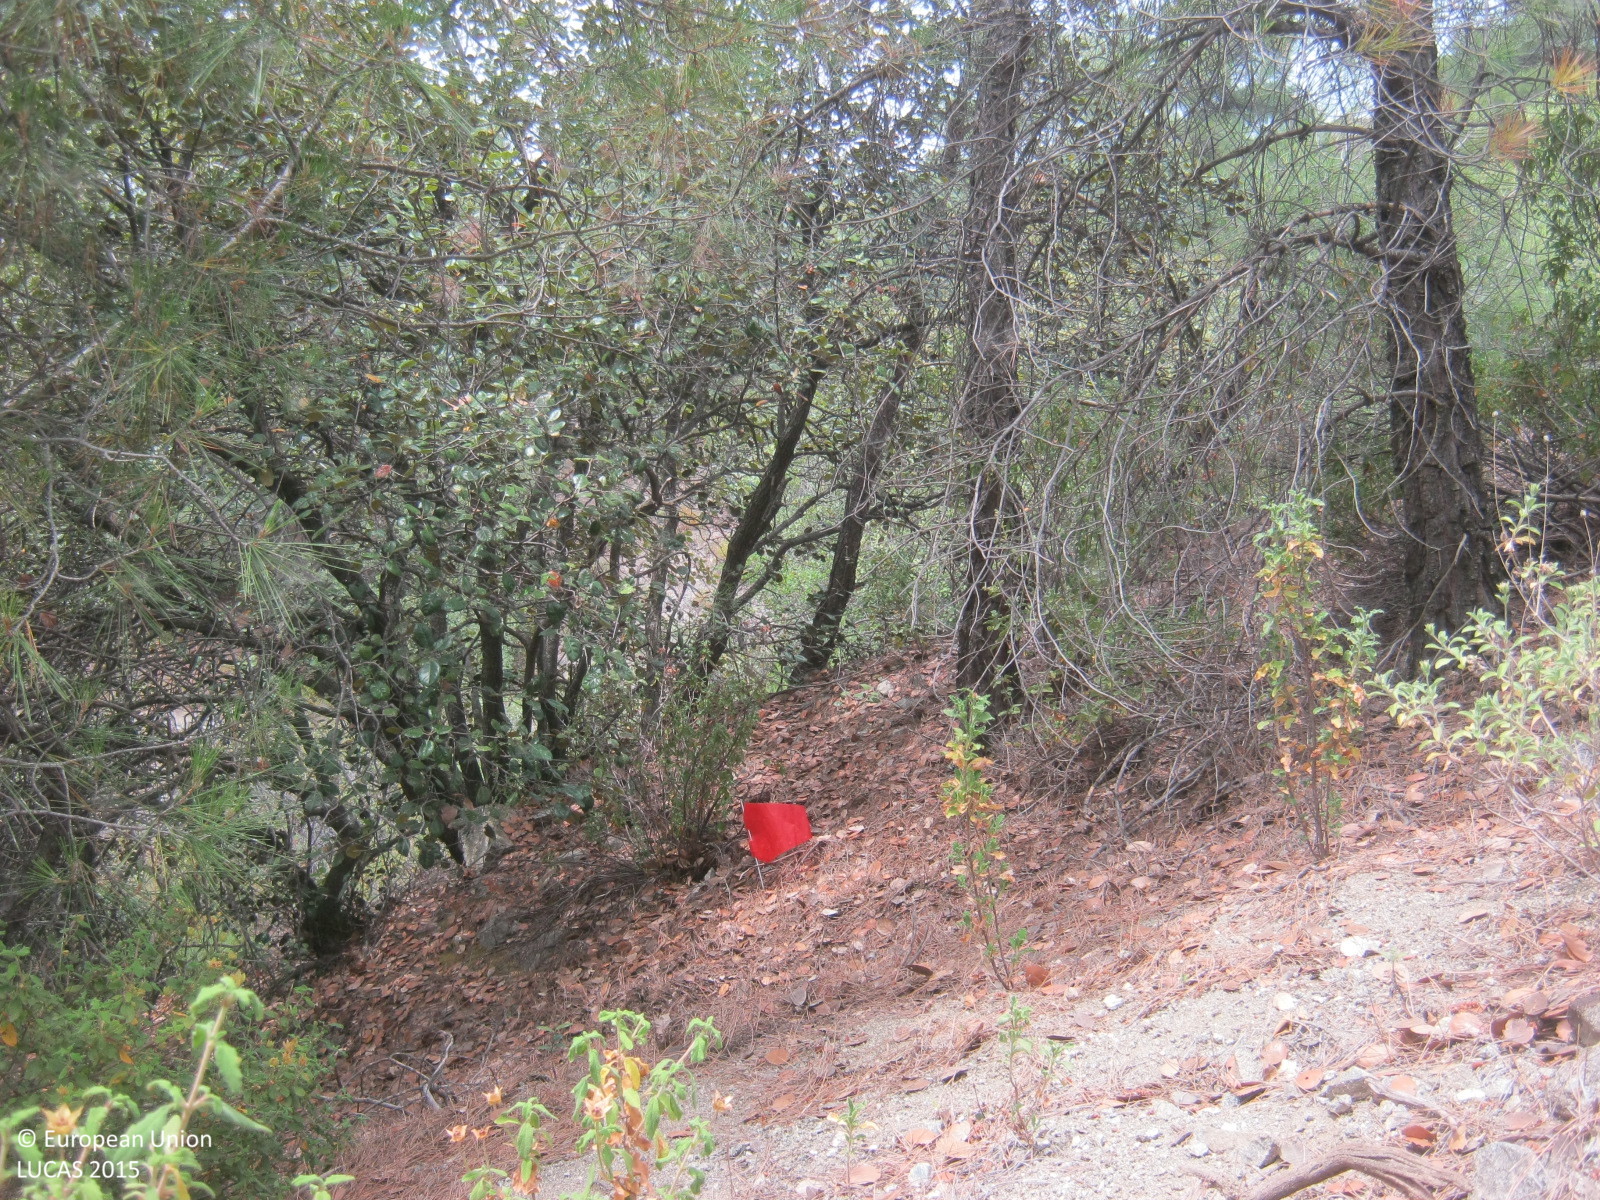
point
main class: Woodland
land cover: Pine dominated mixed woodland
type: coniferous forest of the mediterranean region
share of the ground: > 75 %
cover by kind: coniferous forest trees 45 %, broadleaved forest trees 30 %, unconsolidated bare surface 15 %, shrubs 10 %
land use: Forestry
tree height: > 5 m
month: June
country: CY
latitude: 34.9812
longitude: 32.8538
